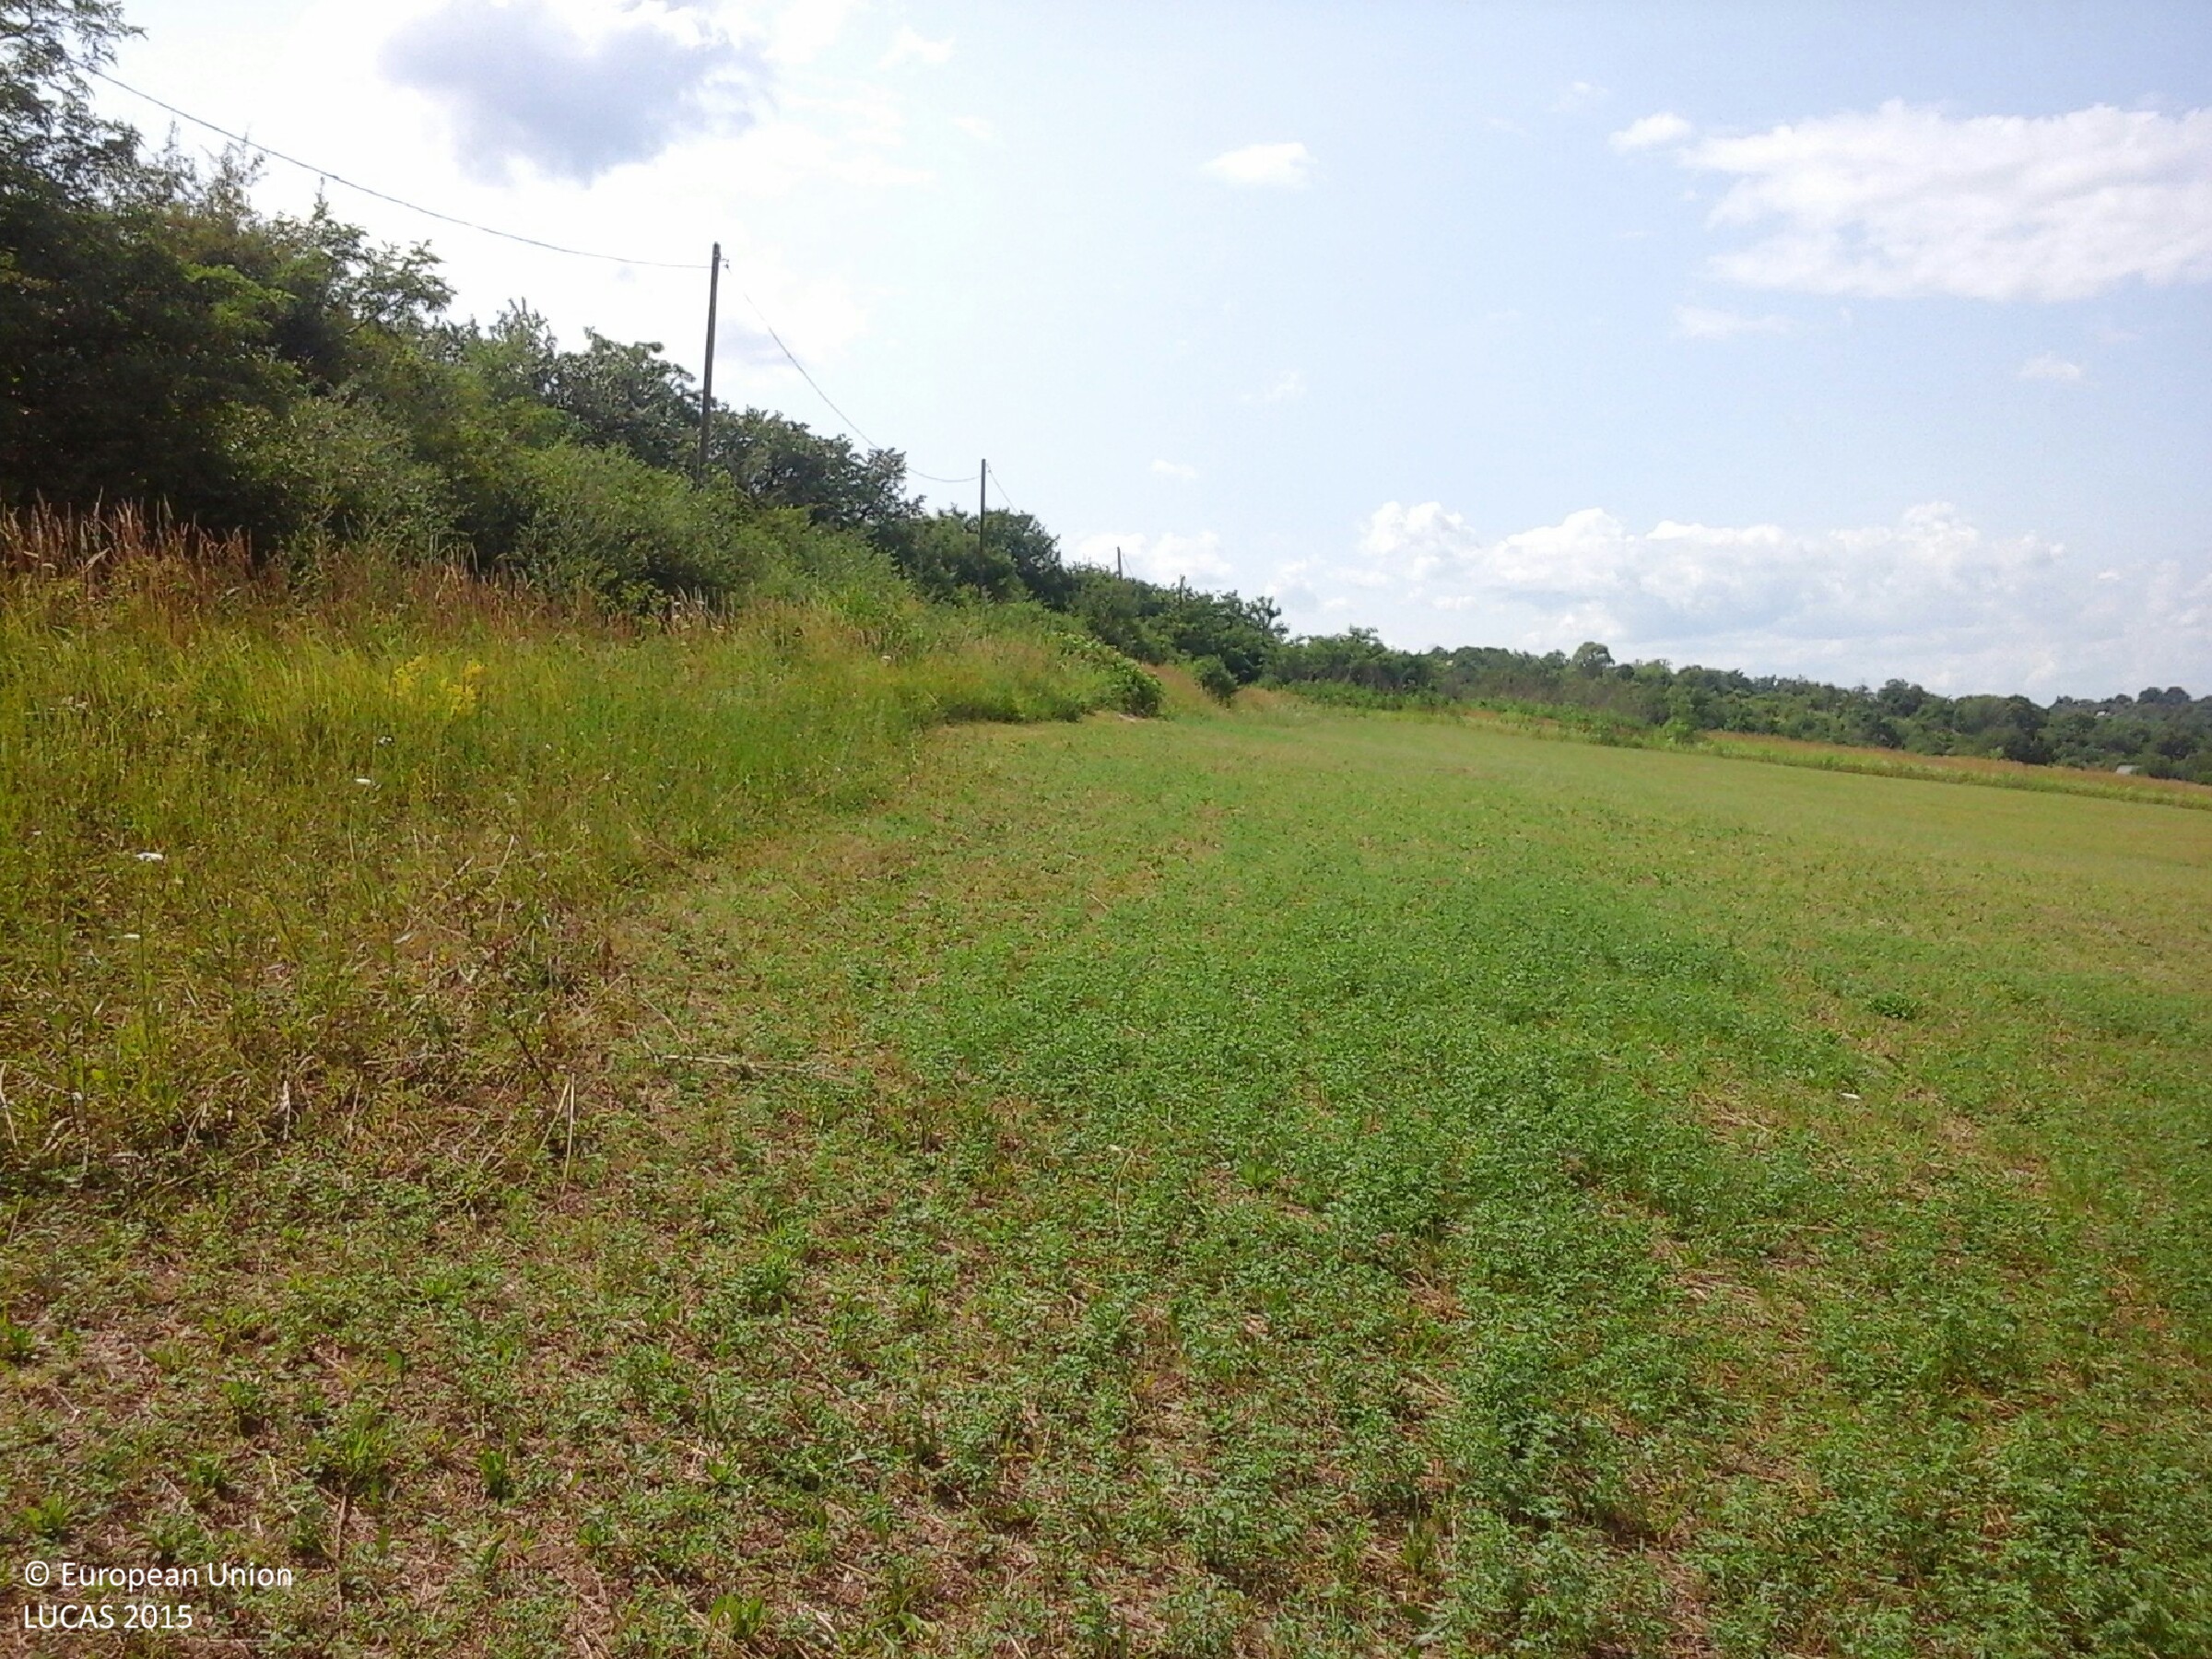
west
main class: Cropland
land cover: Lucerne
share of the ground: > 75 %
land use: Agriculture (excluding fallow land and kitchen gardens)
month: July
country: HU
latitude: 48.1324
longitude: 20.7456
